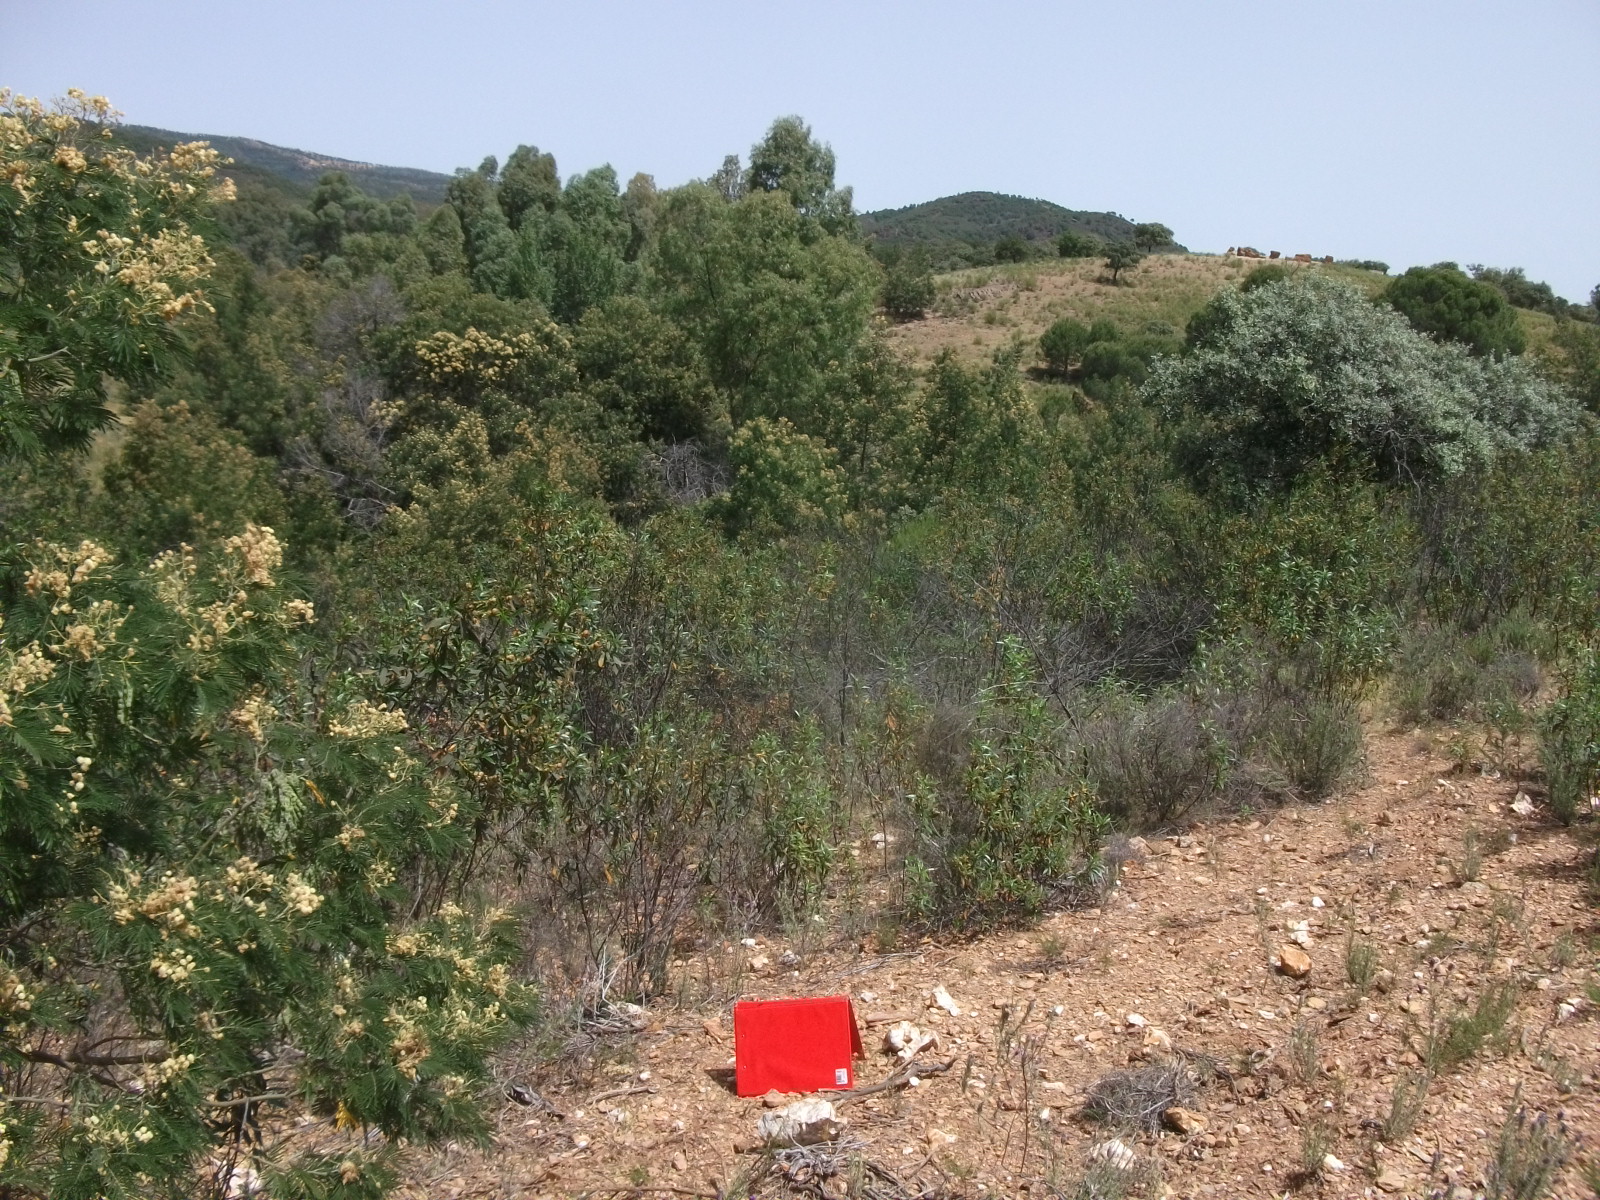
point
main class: Grassland
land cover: Grassland with sparse tree/shrub cover
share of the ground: 25 - 50 %
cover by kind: herbaceous plants 85 %, shrubs 10 %, broadleaved forest trees 5 %
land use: Agriculture (excluding fallow land and kitchen gardens)
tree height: < 5 m
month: May
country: ES
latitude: 37.7981
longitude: -7.0755
